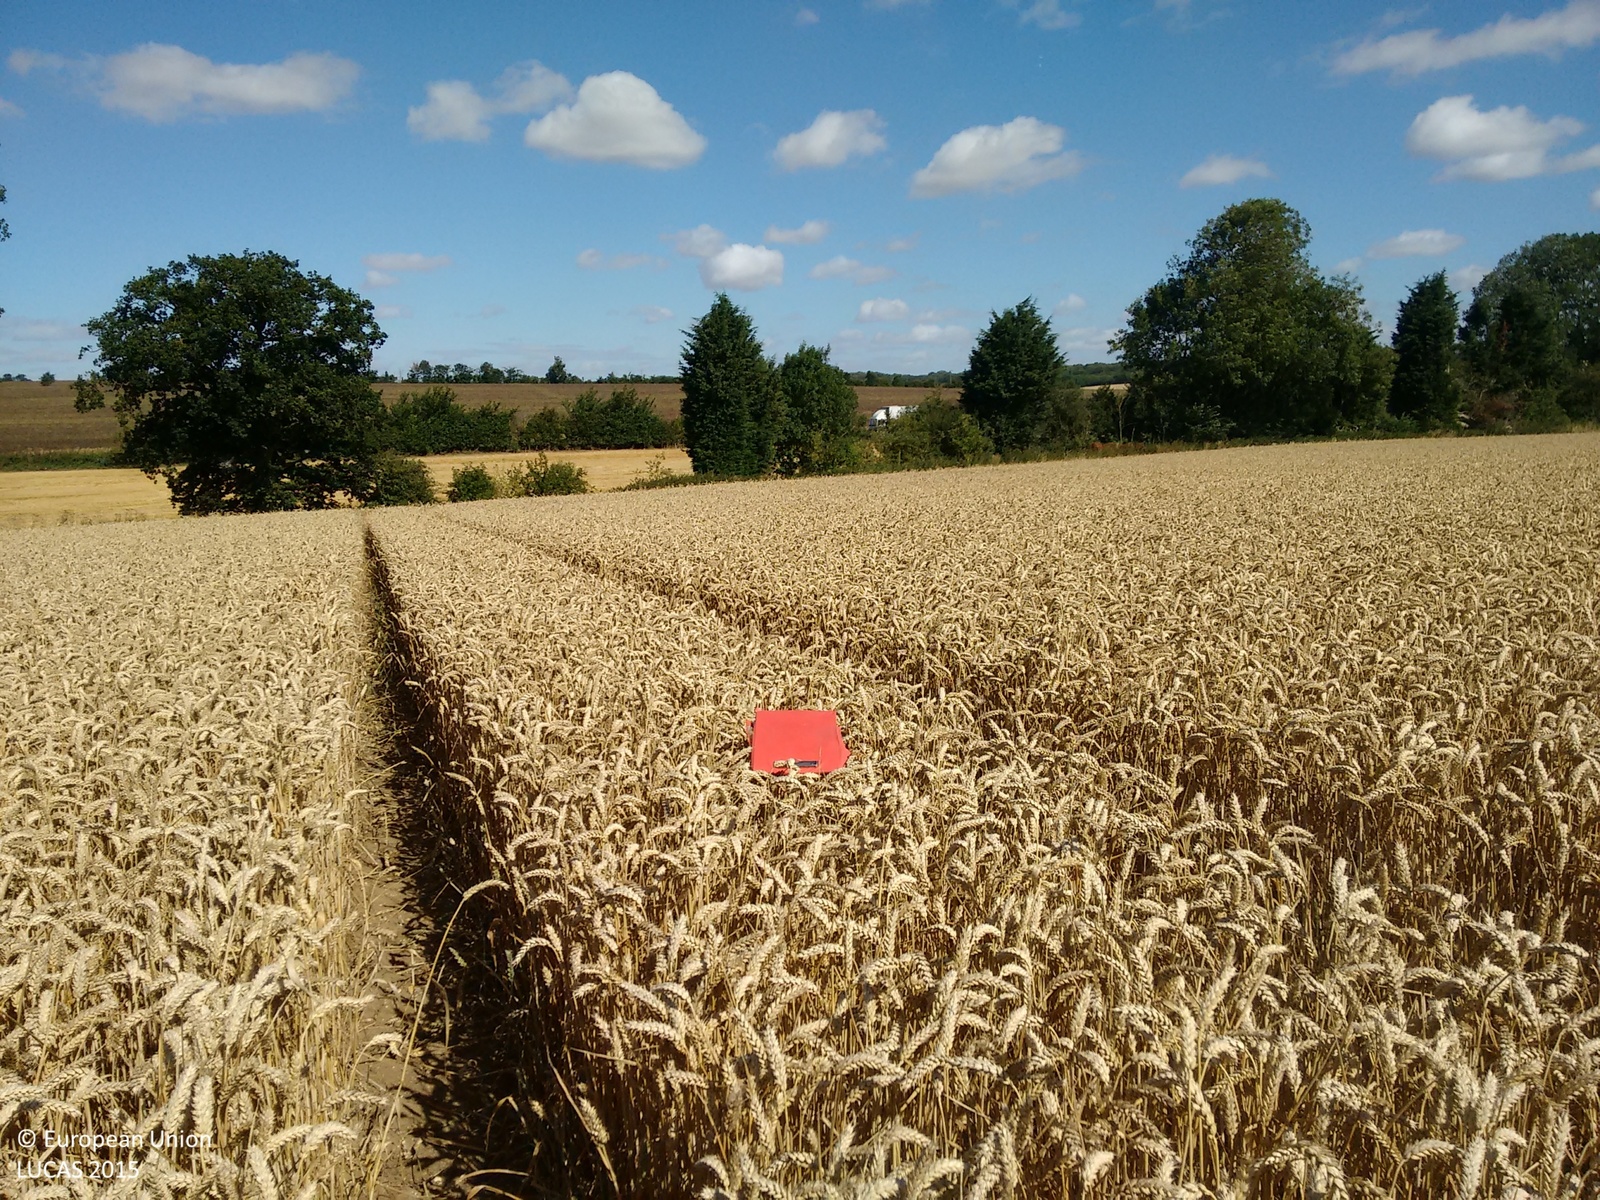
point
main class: Cropland
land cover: Common wheat
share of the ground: > 75 %
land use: Agriculture (excluding fallow land and kitchen gardens)
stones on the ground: 25 - 50 %
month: August
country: GB
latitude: 52.0947
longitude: 0.3811
